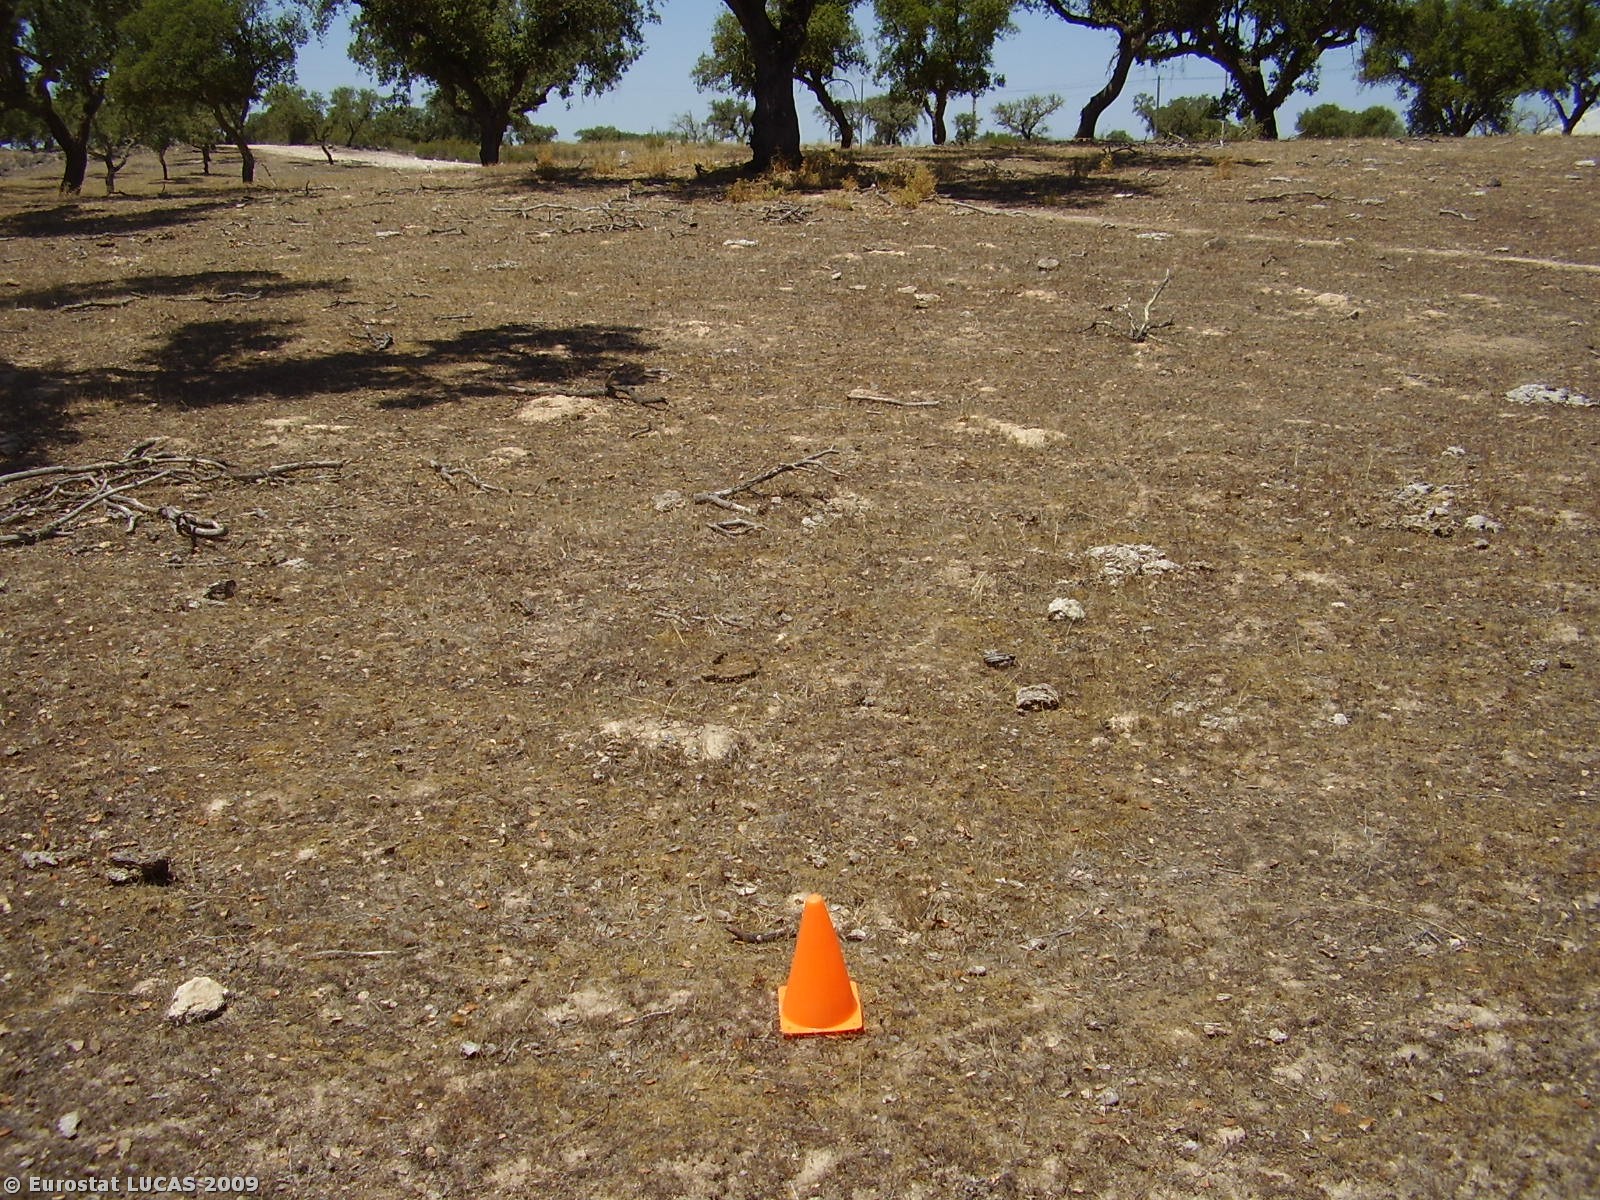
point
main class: Woodland
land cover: Broadleaved woodland
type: broadleaved evergreen forest
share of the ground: 10 - 25 %
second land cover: Grassland with sparse tree/shrub cover
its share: 50 - 75 %
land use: Forestry
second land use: Fallow land
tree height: > 5 m
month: July
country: PT
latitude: 38.8477
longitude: -7.8920
